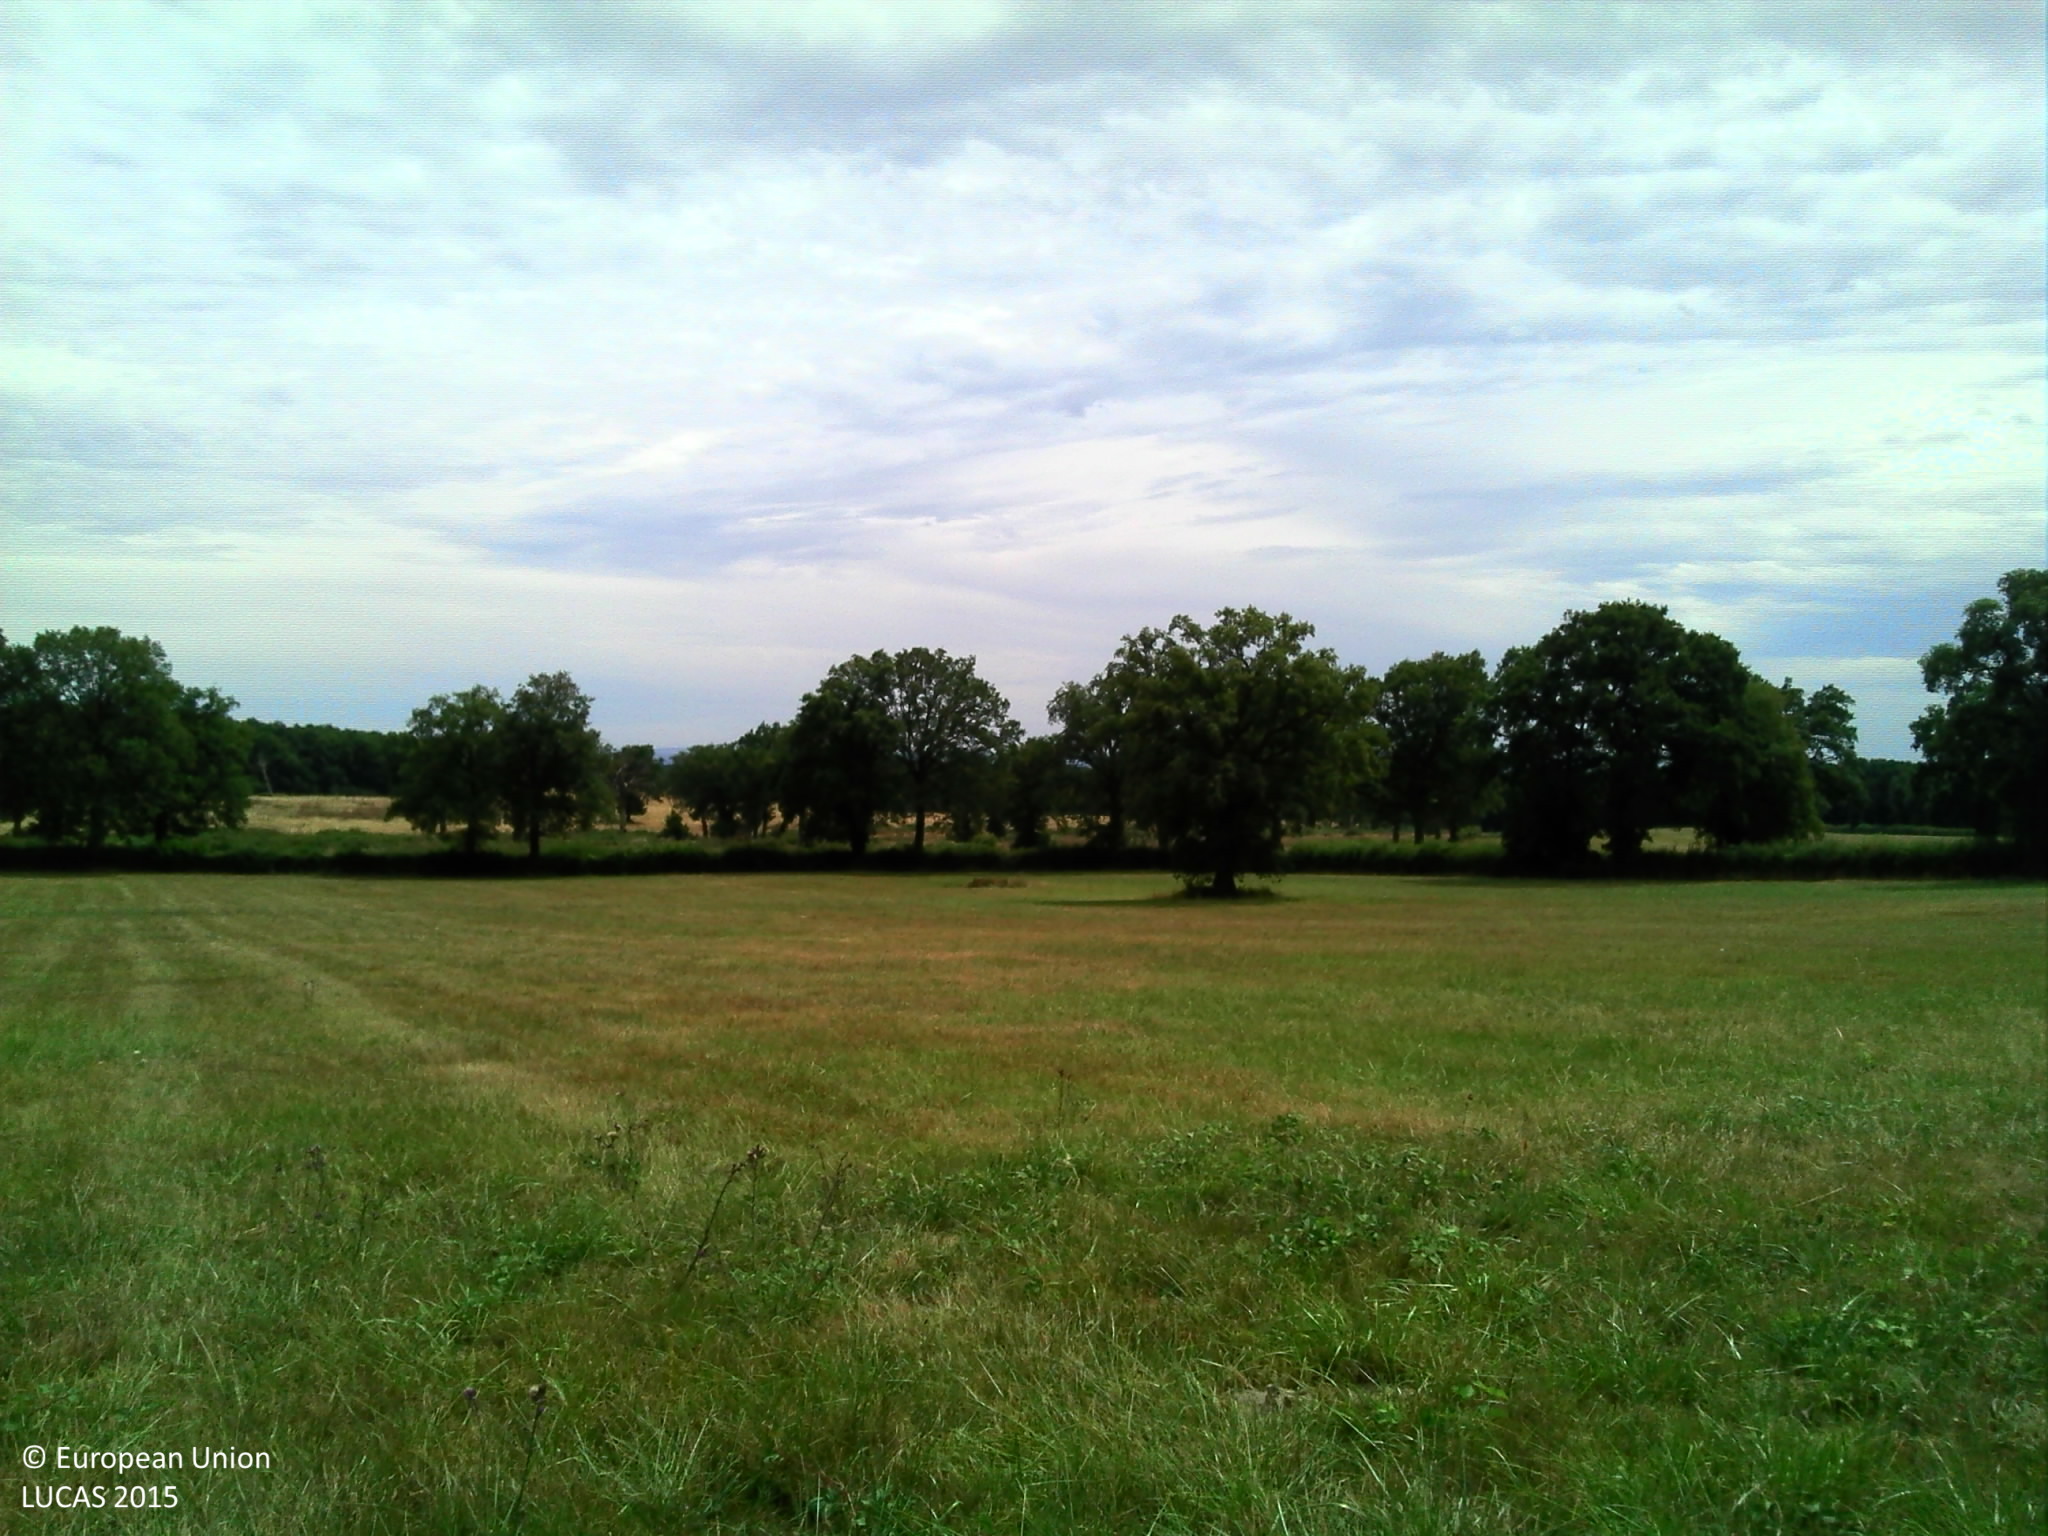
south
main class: Grassland
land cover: Grassland without tree/shrub cover
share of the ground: > 75 %
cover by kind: herbaceous plants 100 %
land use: Agriculture (excluding fallow land and kitchen gardens)
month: July
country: FR
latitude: 46.5575
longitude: 2.7566
